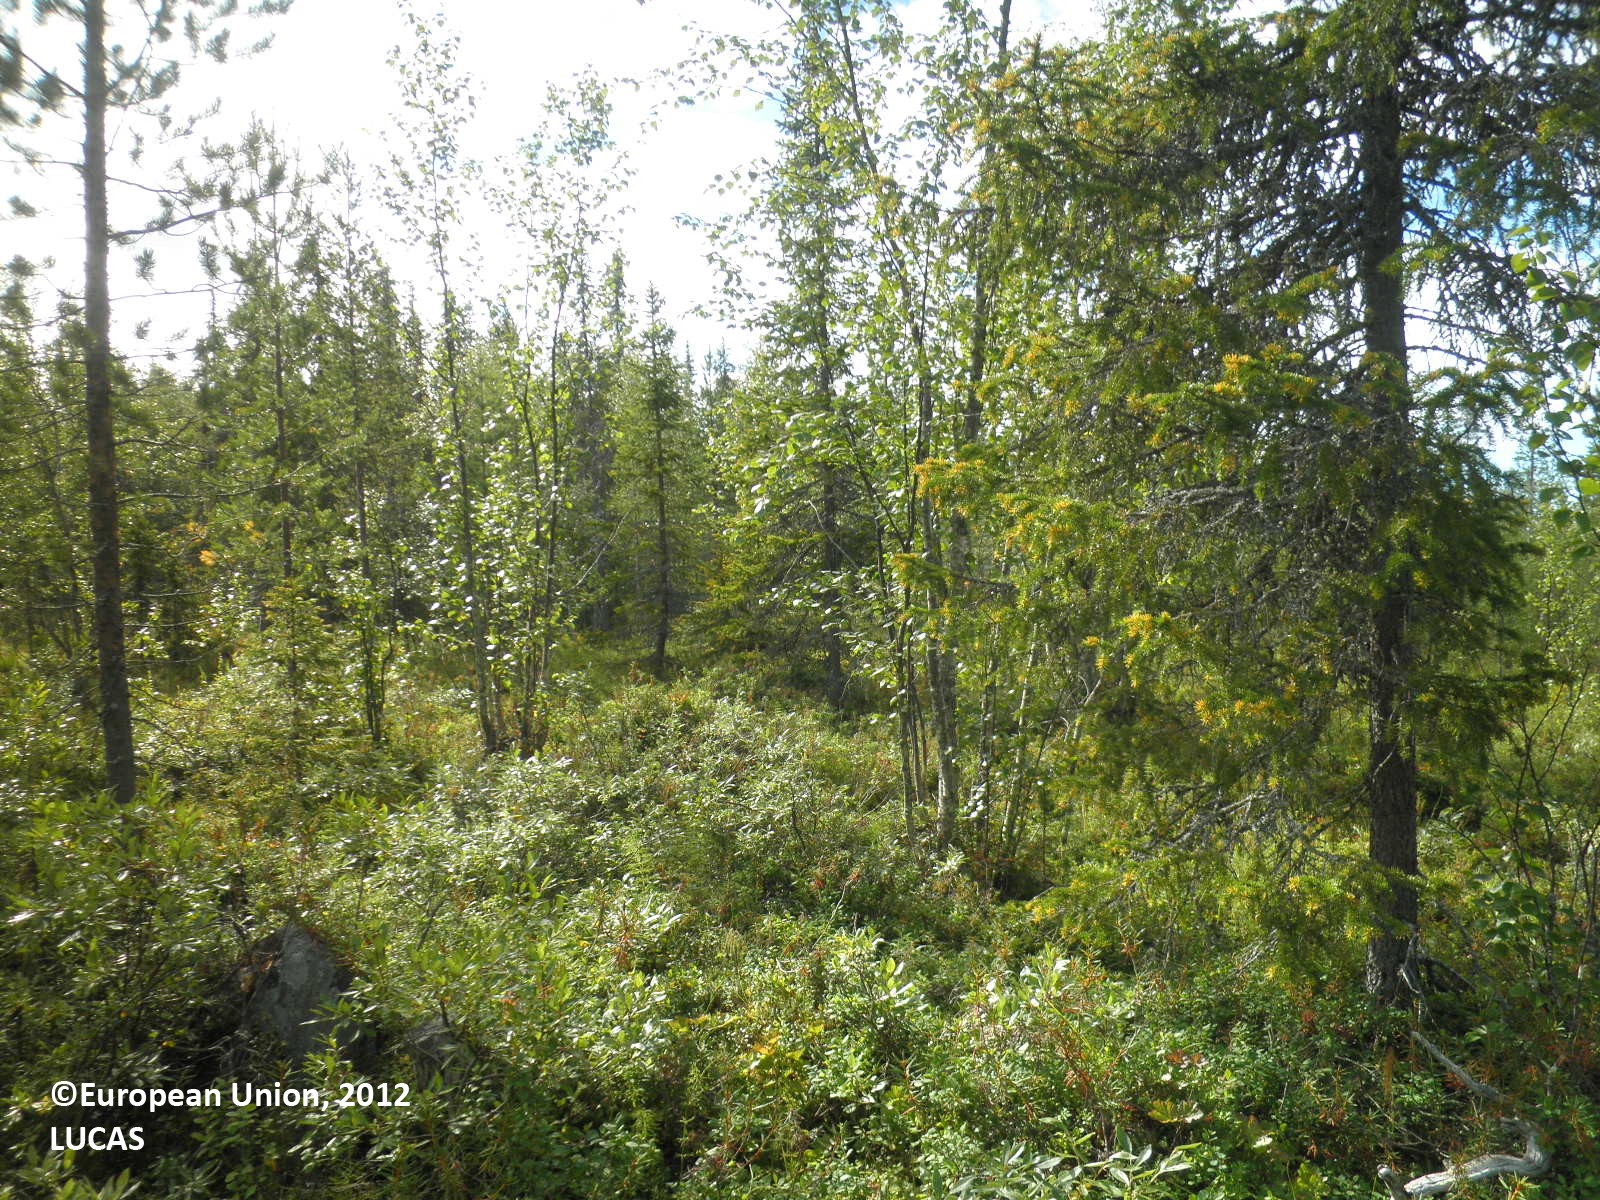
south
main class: Woodland
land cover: Pine dominated mixed woodland
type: boreal forest
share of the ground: 25 - 50 %
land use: Forestry
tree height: > 5 m
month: August
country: FI
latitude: 67.5038
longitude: 27.0653
